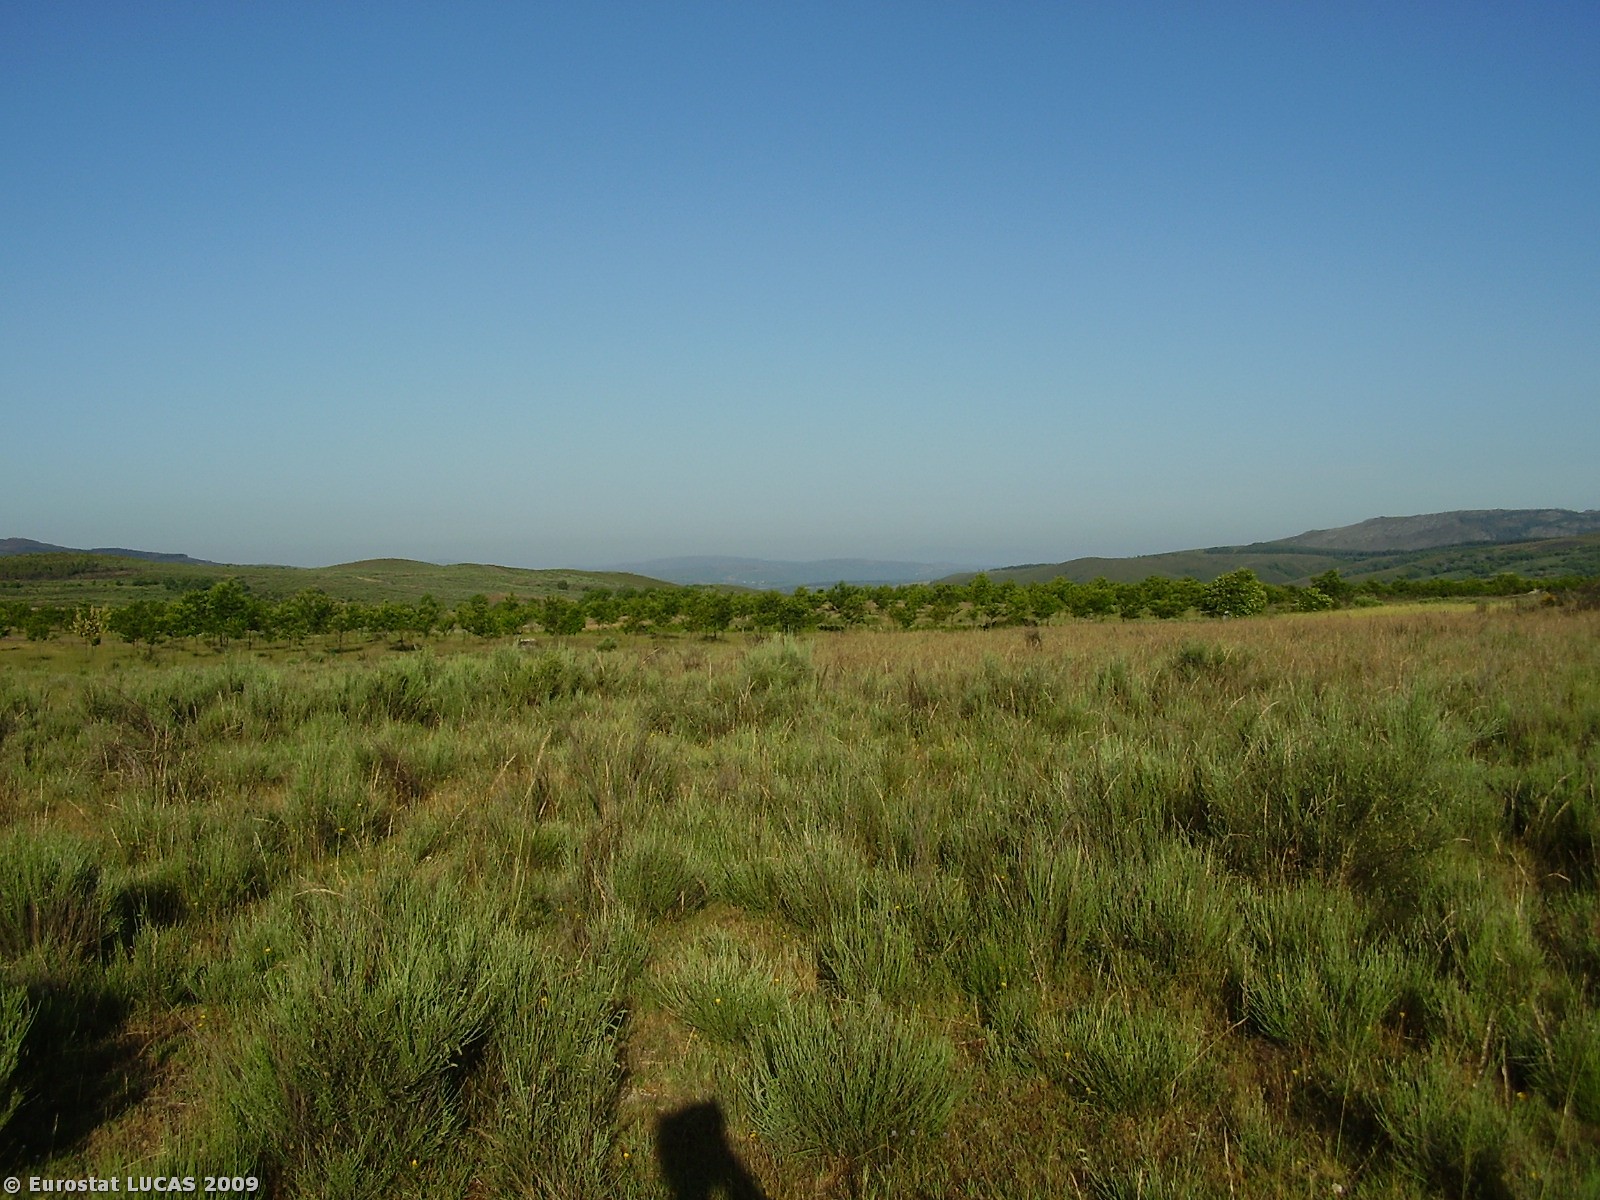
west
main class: Grassland
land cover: Spontaneously vegetated surfaces
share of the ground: > 75 %
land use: Nature reserves
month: June
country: PT
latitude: 41.9595
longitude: -7.0005
